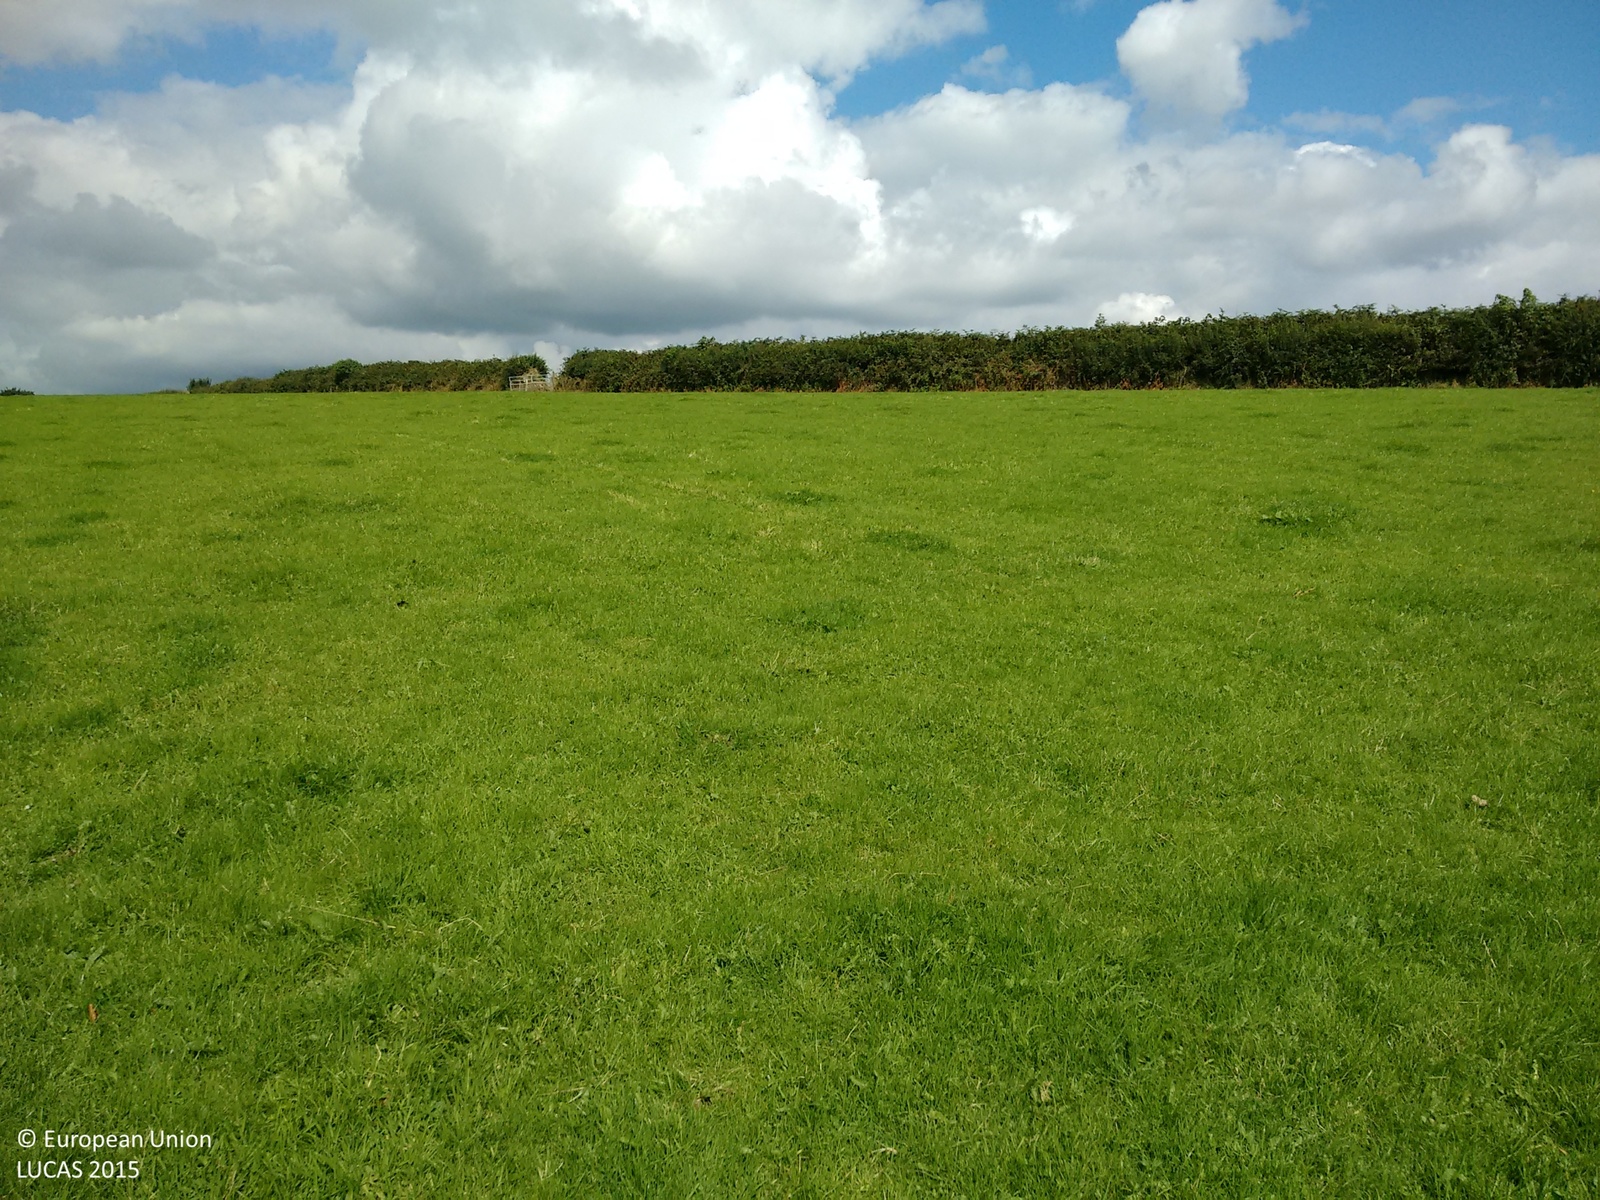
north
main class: Grassland
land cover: Grassland without tree/shrub cover
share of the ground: > 75 %
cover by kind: herbaceous plants 100 %
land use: Agriculture (excluding fallow land and kitchen gardens)
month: September
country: GB
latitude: 50.5747
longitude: -4.1469
